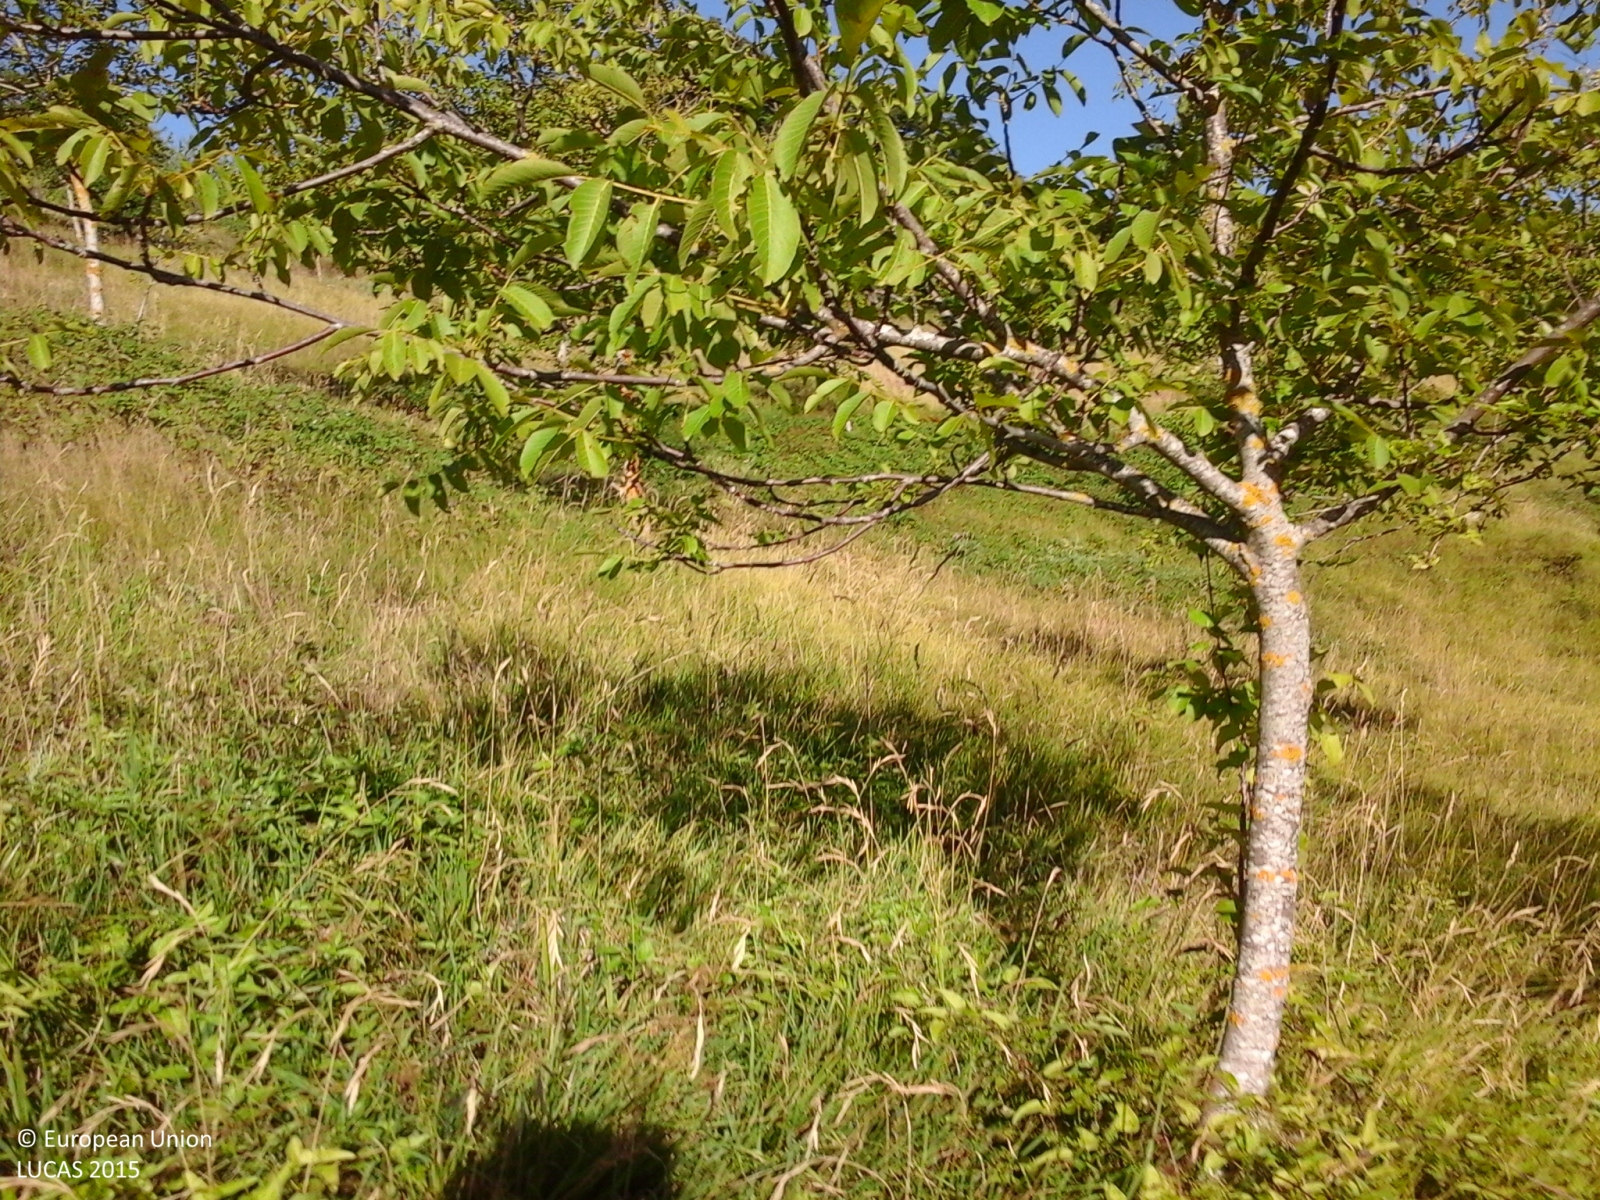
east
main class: Cropland
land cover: Nuts trees
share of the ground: 25 - 50 %
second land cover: Grassland without tree/shrub cover
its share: > 75 %
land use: Agriculture (excluding fallow land and kitchen gardens)
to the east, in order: Nuts trees; Grassland without tree/shrub cover; Broadleaved woodland; Shrubland without tree cover; Lucerne; Shrubland with sparse tree cover; Electric lines; Shrubland with sparse tree cover; Lucerne; Shrubland with sparse tree cover; Paved roads, cycling and walking lanes; Shrubland with sparse tree cover; Broadleaved woodland; Electric lines; Broadleaved woodland
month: August
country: IT
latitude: 43.5279
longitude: 12.4312
